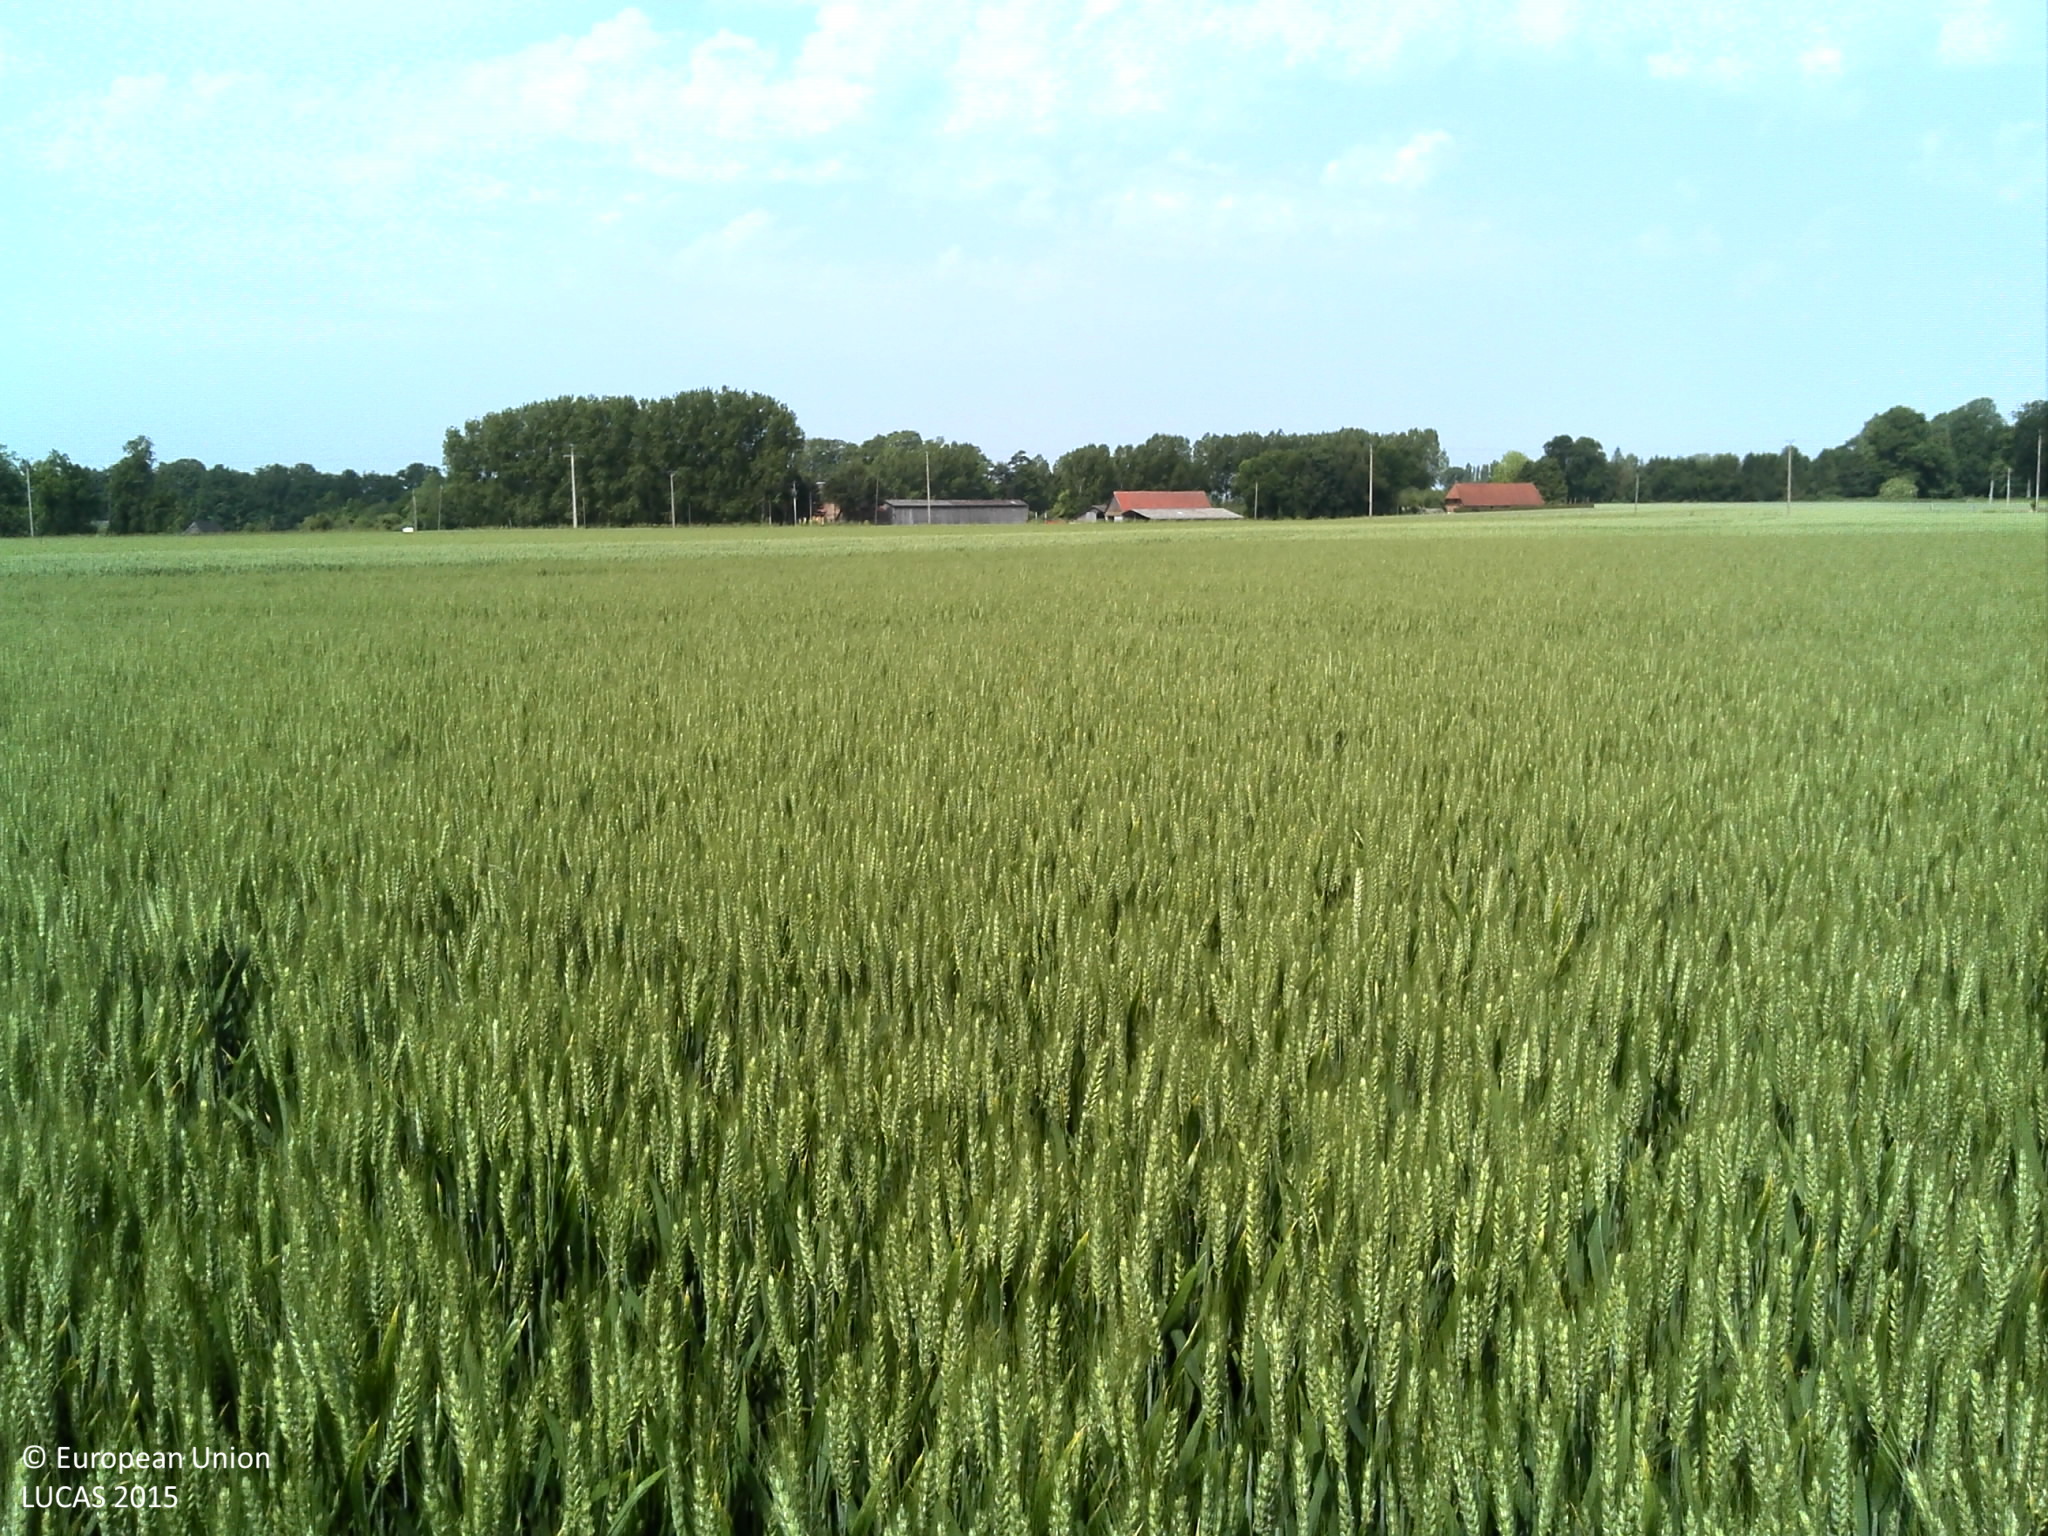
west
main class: Cropland
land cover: Common wheat
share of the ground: > 75 %
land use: Agriculture (excluding fallow land and kitchen gardens)
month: June
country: FR
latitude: 49.7595
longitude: 1.0519
